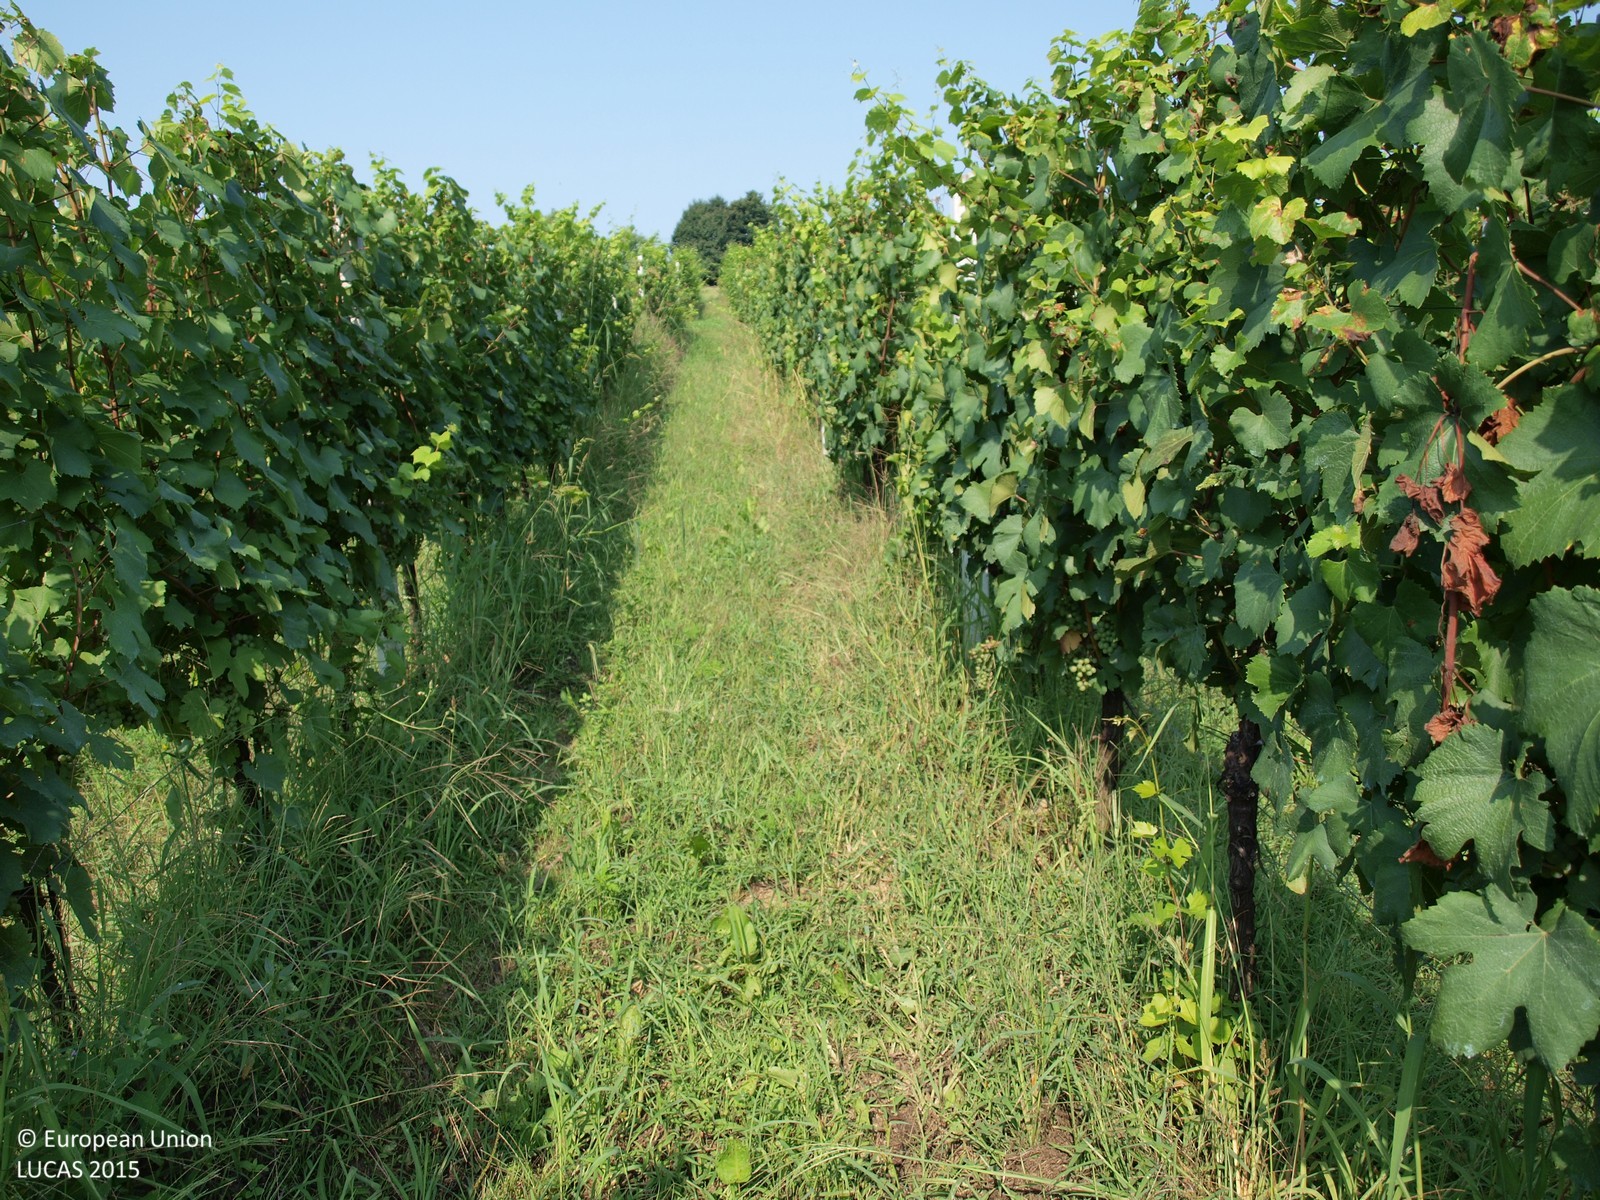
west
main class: Cropland
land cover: Vineyards
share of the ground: 50 - 75 %
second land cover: Grassland without tree/shrub cover
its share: 50 - 75 %
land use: Agriculture (excluding fallow land and kitchen gardens)
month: August
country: HR
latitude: 45.9241
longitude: 16.4080
